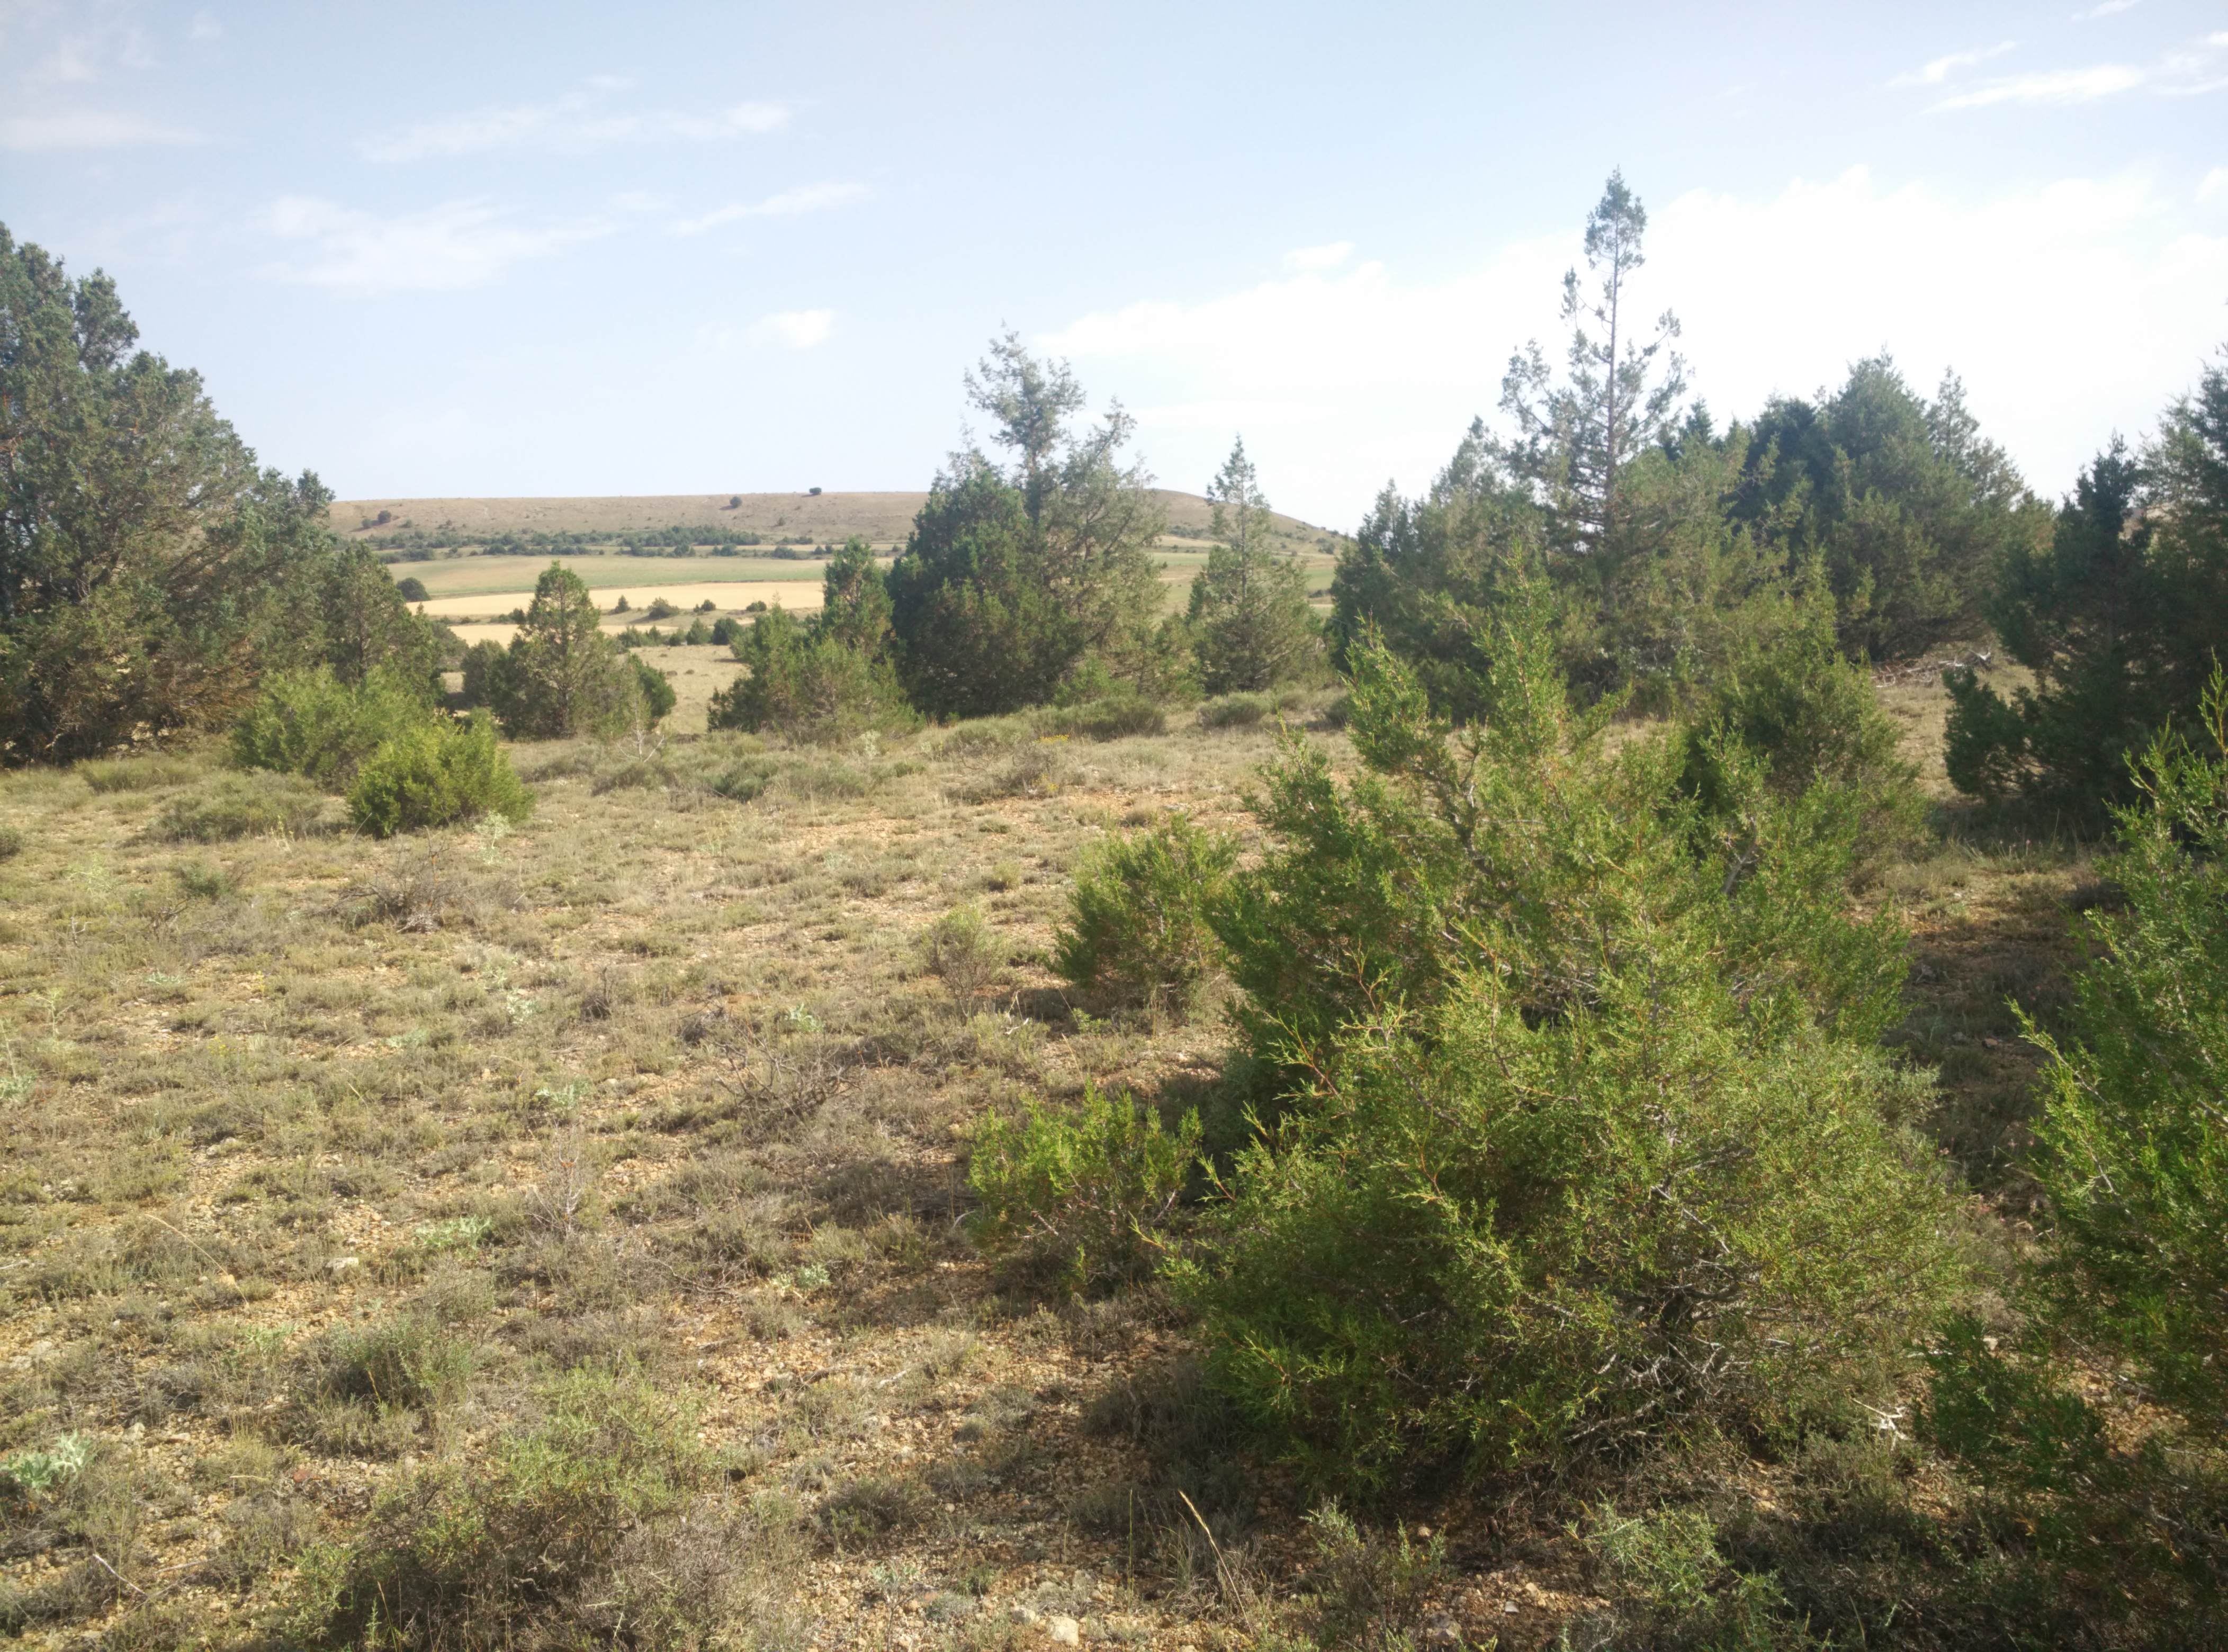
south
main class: Woodland
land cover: Other coniferous woodland
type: coniferous forest of the mediterranean region
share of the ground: 10 - 25 %
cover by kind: unconsolidated bare surface 50 %, shrubs 25 %, coniferous forest trees 20 %, herbaceous plants 5 %
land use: Semi-natural and natural areas not in use
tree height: > 5 m
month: July
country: ES
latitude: 41.0495
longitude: -2.1023
